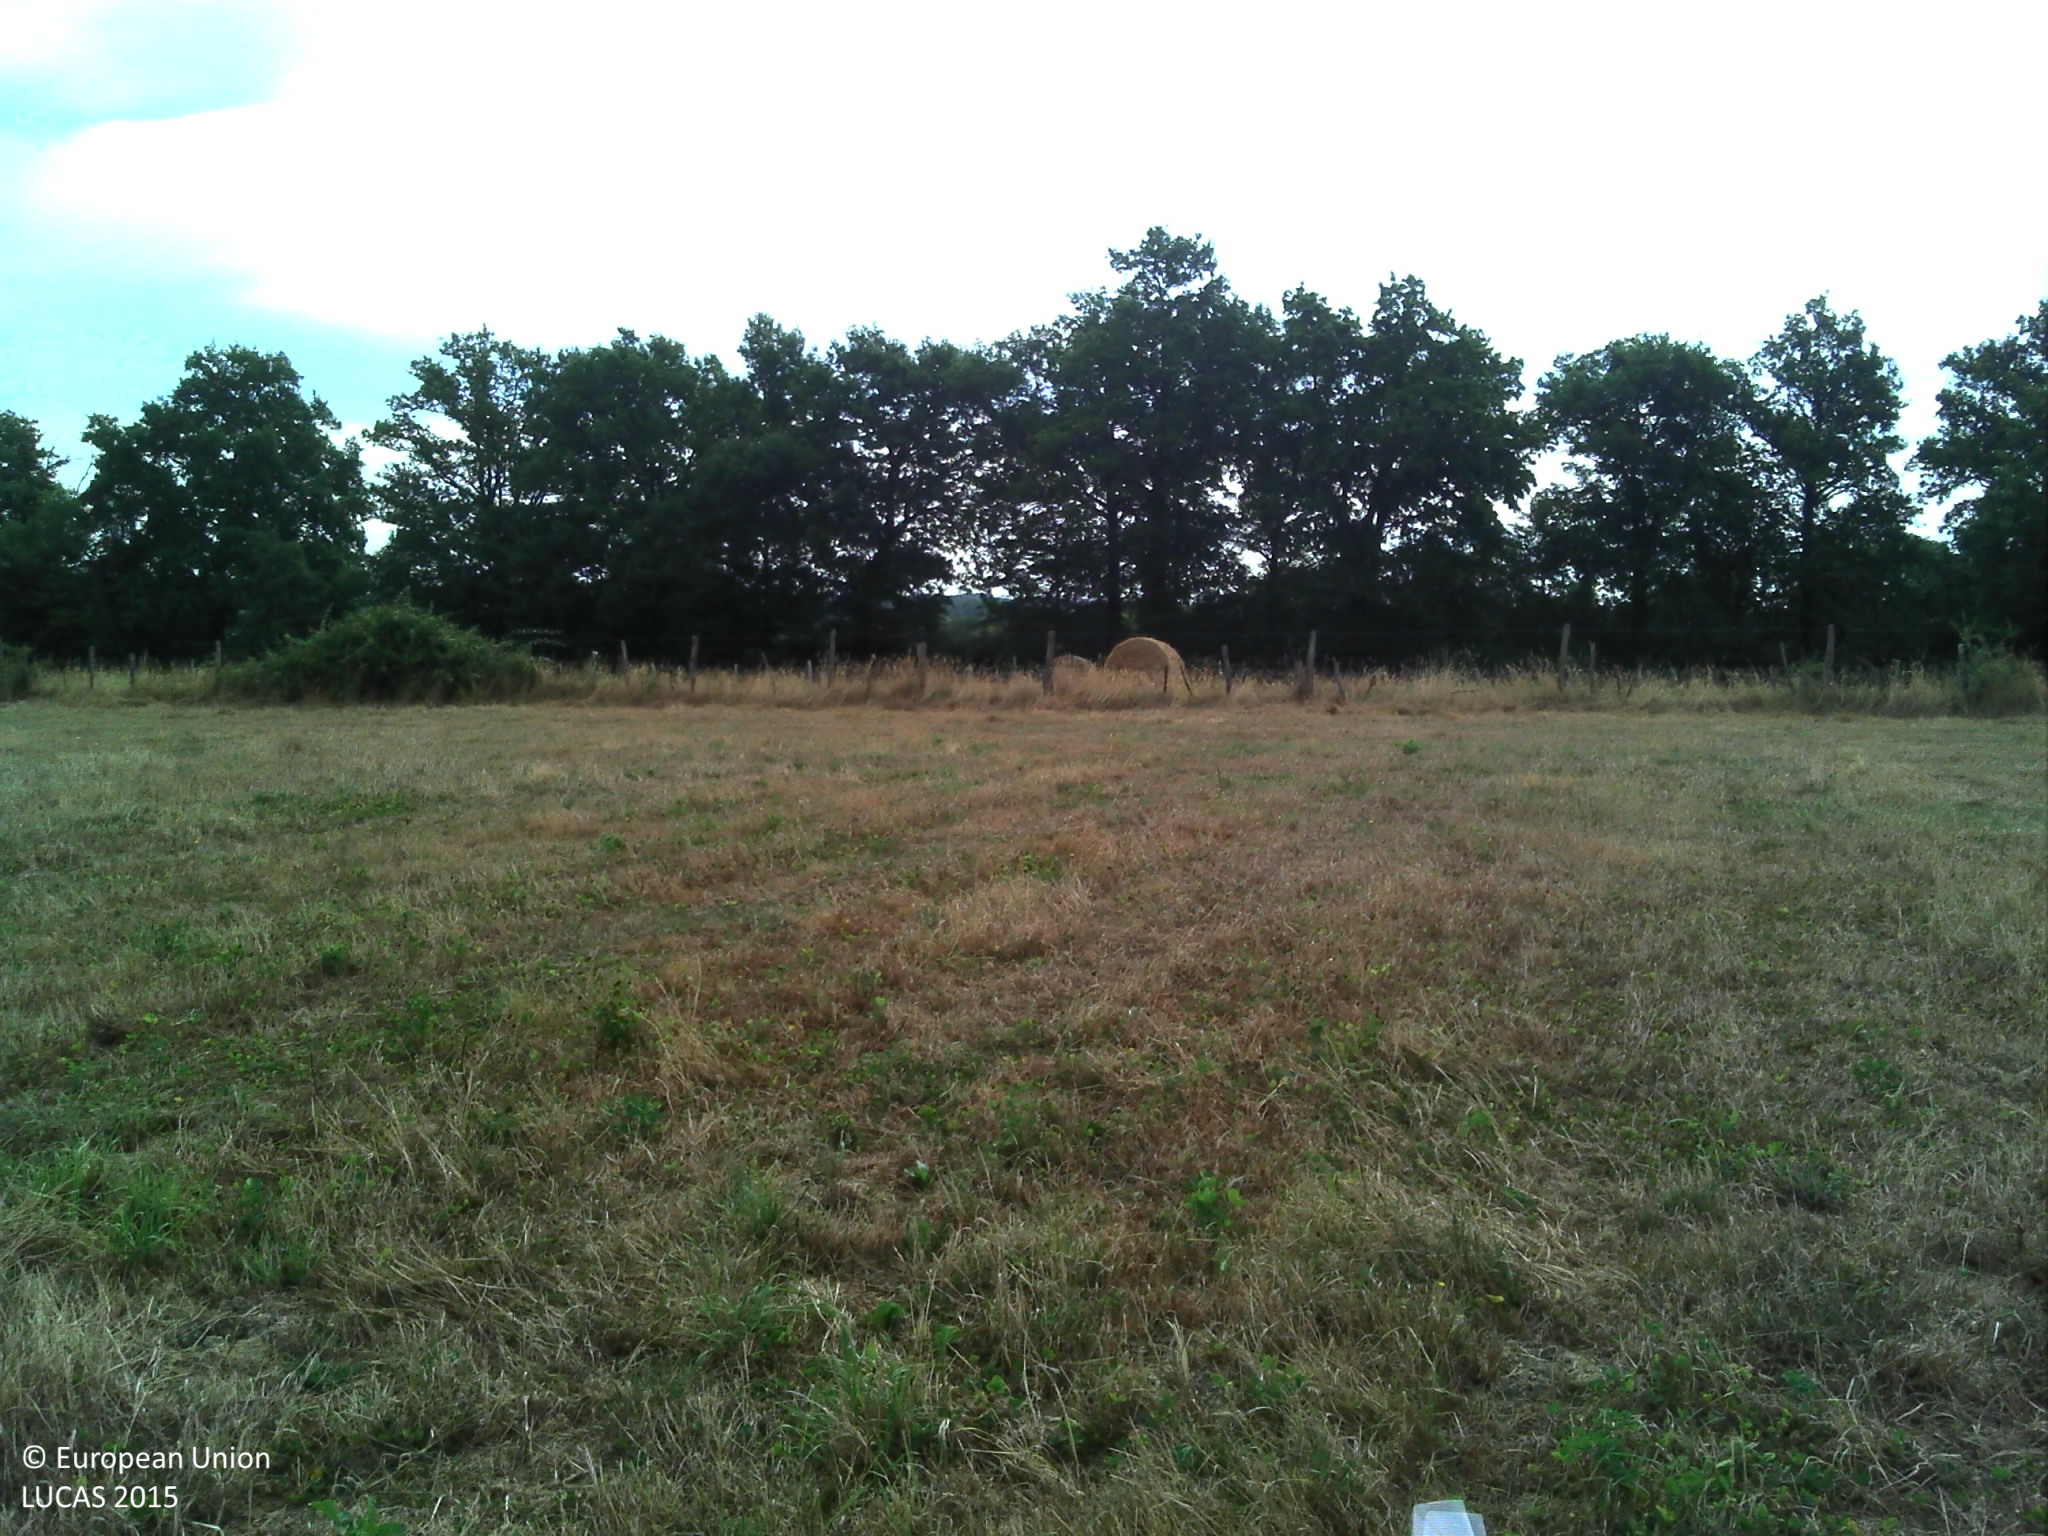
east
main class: Grassland
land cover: Grassland without tree/shrub cover
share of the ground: > 75 %
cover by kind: herbaceous plants 100 %
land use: Agriculture (excluding fallow land and kitchen gardens)
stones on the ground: > 50 %
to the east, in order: Grassland without tree/shrub cover; Fences; Grassland without tree/shrub cover; Fences; Grassland without tree/shrub cover; Fences; Groves; Tracks; Groves; Fences; Grassland without tree/shrub cover; Fences; Lines of trees; Grassland without tree/shrub cover; Fences; Grassland without tree/shrub cover
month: July
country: FR
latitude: 46.2542
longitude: 0.9194
